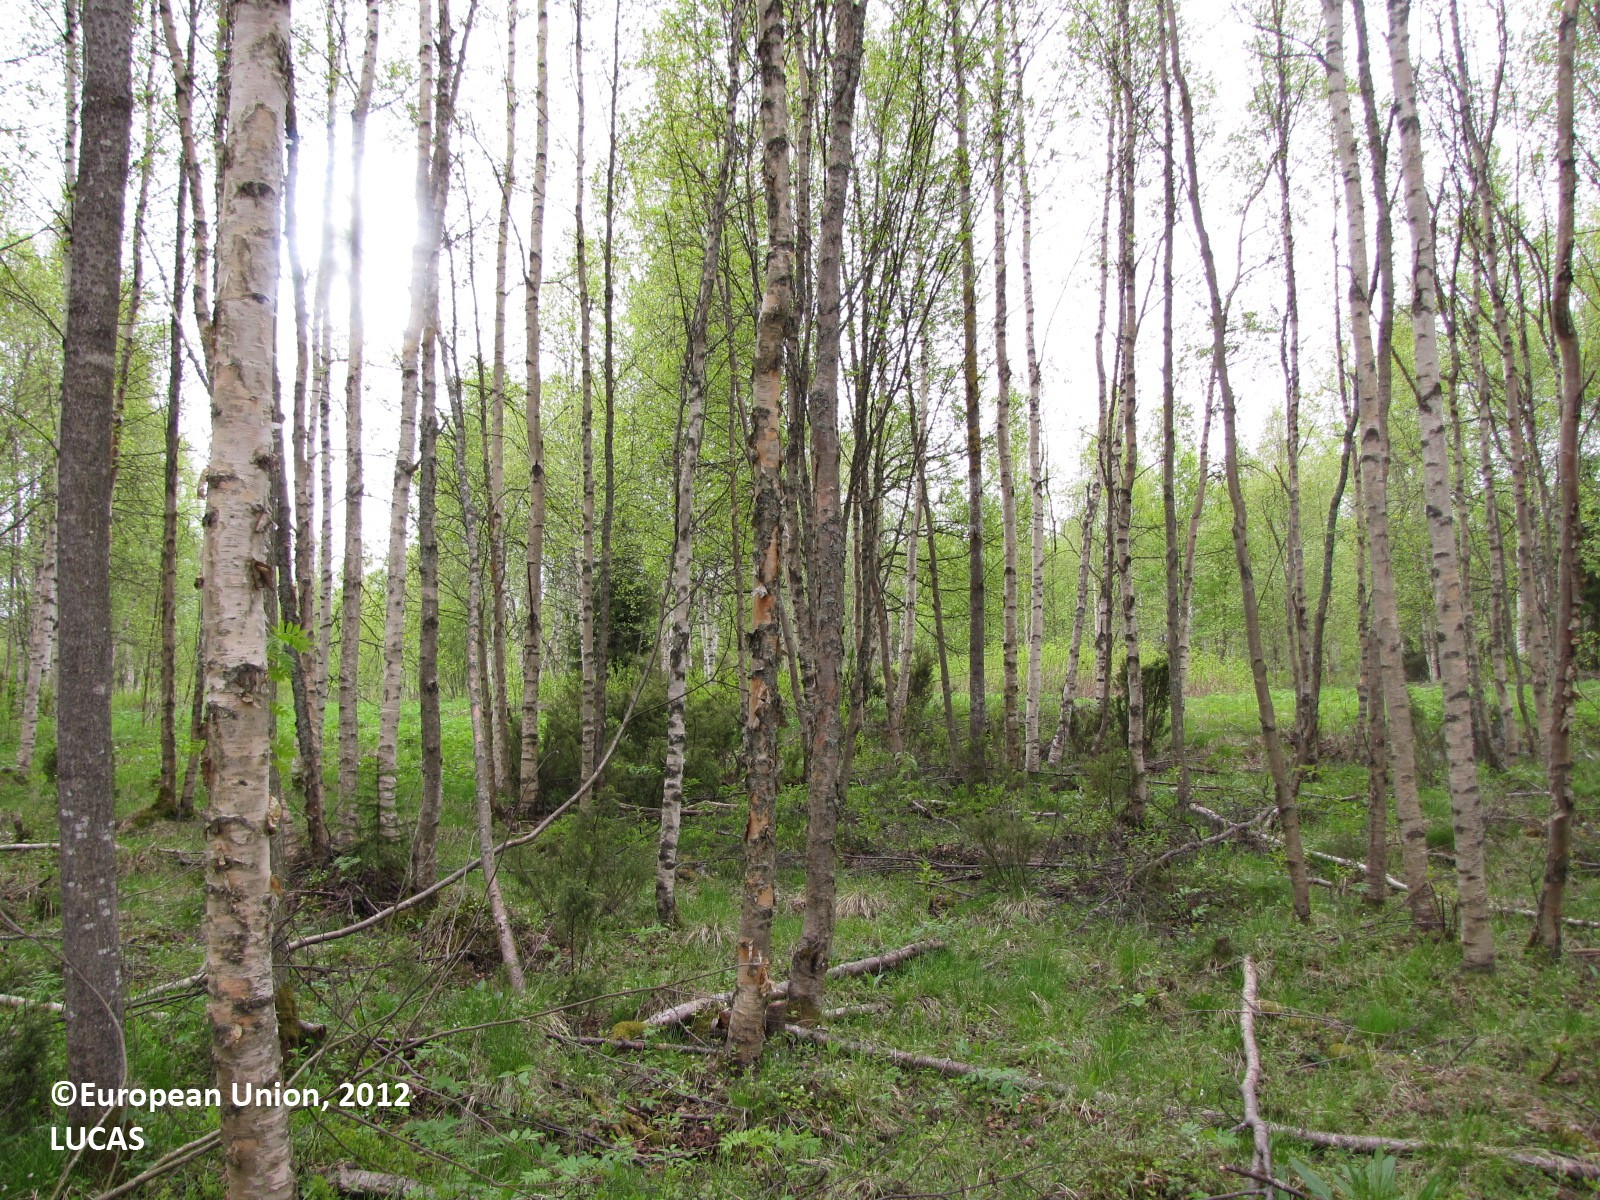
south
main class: Woodland
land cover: Broadleaved woodland
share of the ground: > 75 %
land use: Forestry
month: June
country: FI
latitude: 65.8369
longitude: 24.2134
